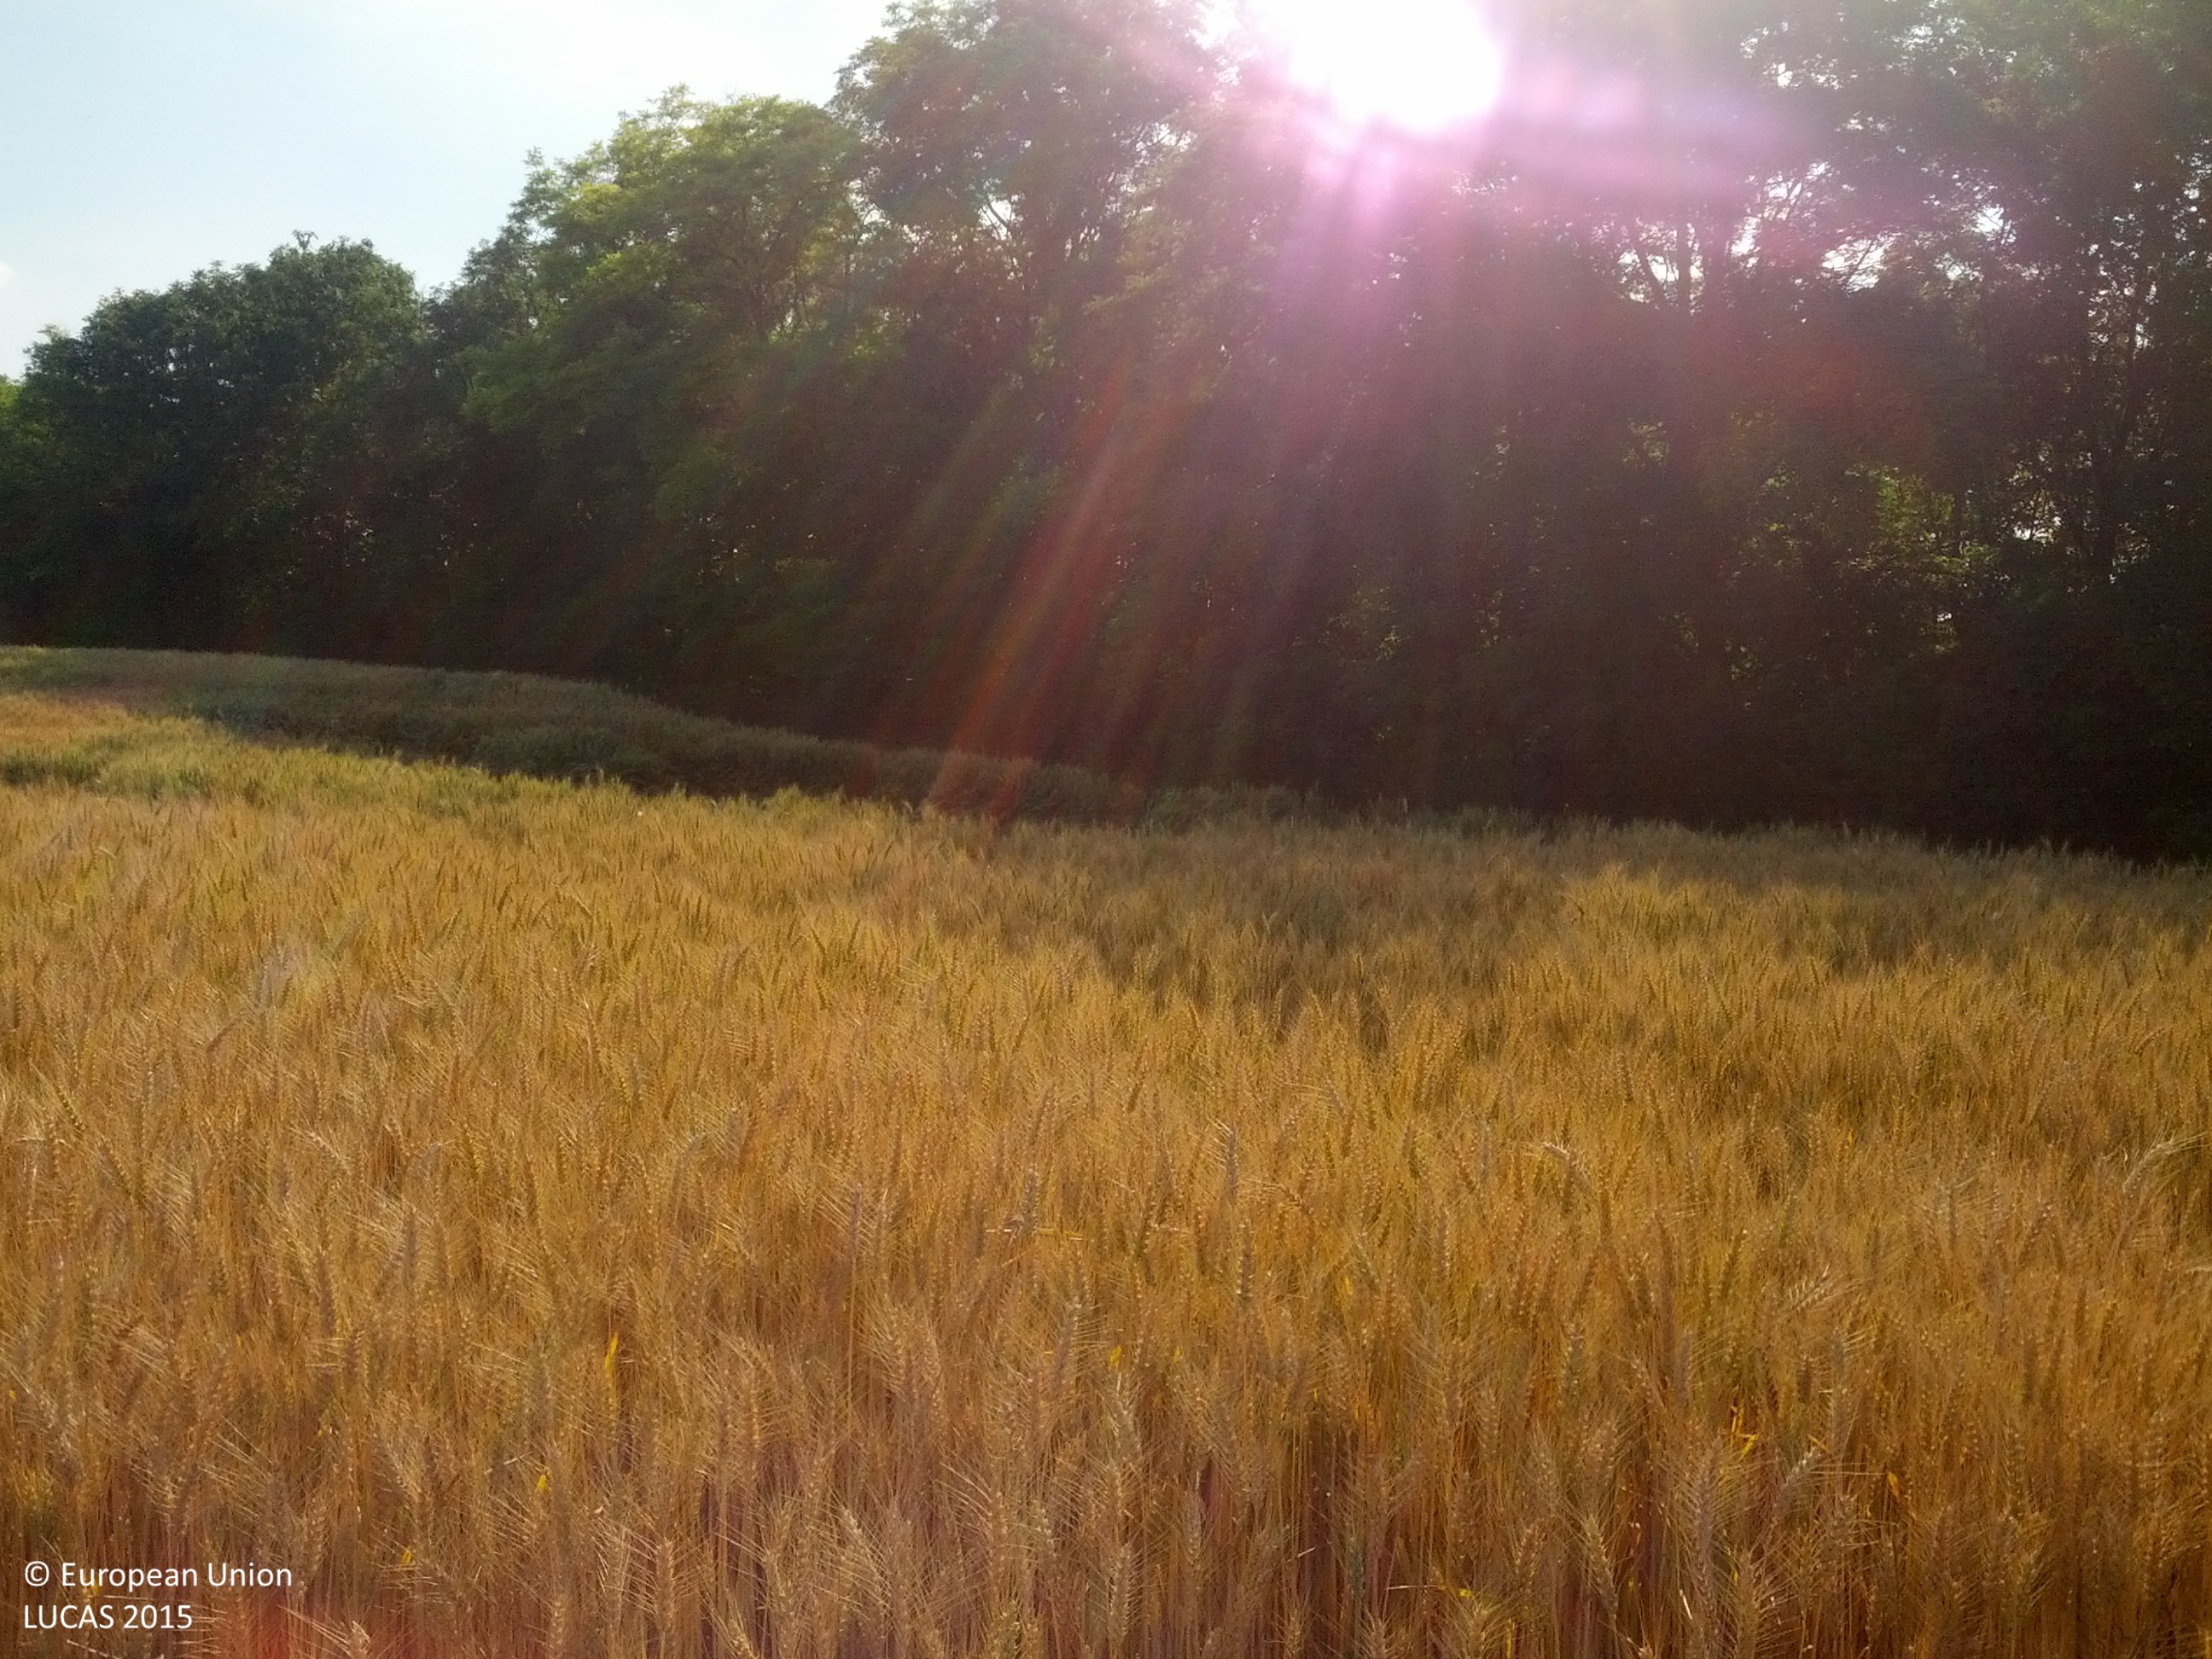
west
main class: Cropland
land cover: Common wheat
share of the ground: > 75 %
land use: Agriculture (excluding fallow land and kitchen gardens)
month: July
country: AT
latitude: 48.5946
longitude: 16.7460
